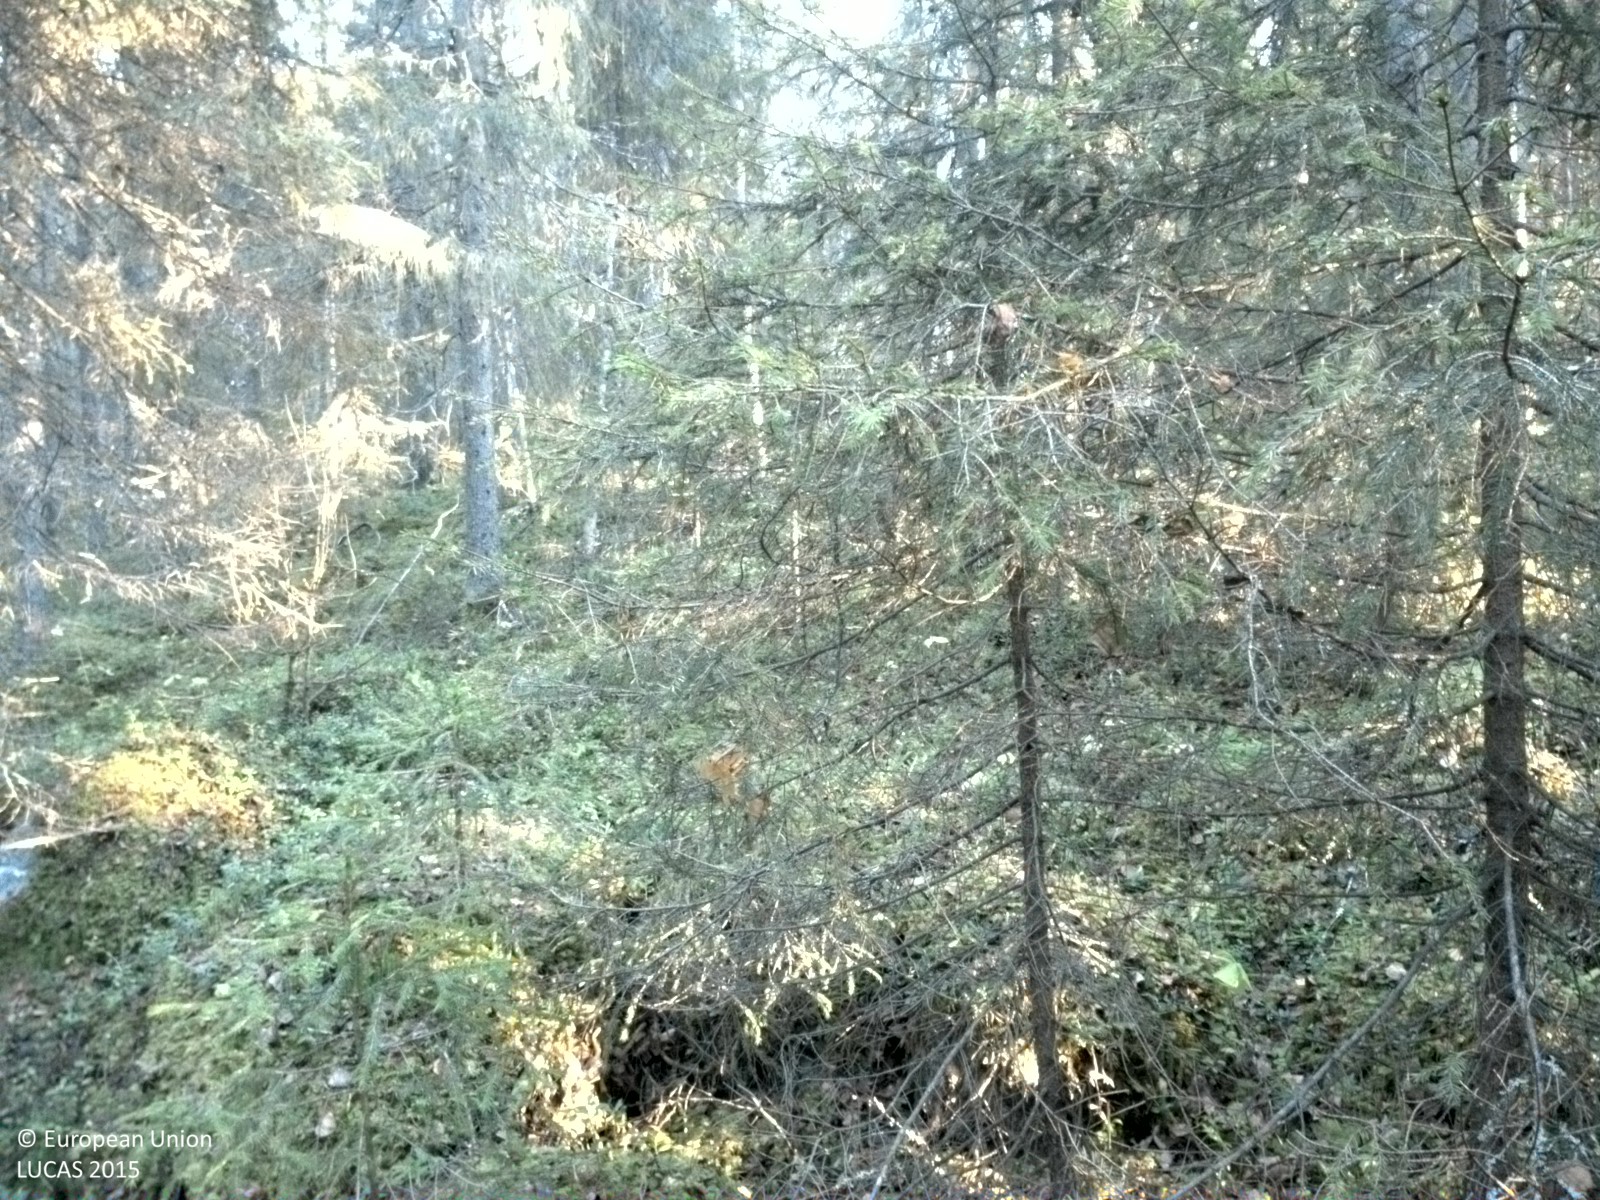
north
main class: Woodland
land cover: Spruce dominated coniferous woodland
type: boreal forest
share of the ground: 25 - 50 %
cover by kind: shrubs 55 %, coniferous forest trees 45 %
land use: Forestry
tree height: > 5 m
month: October
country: SE
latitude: 65.8814
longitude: 22.2809
